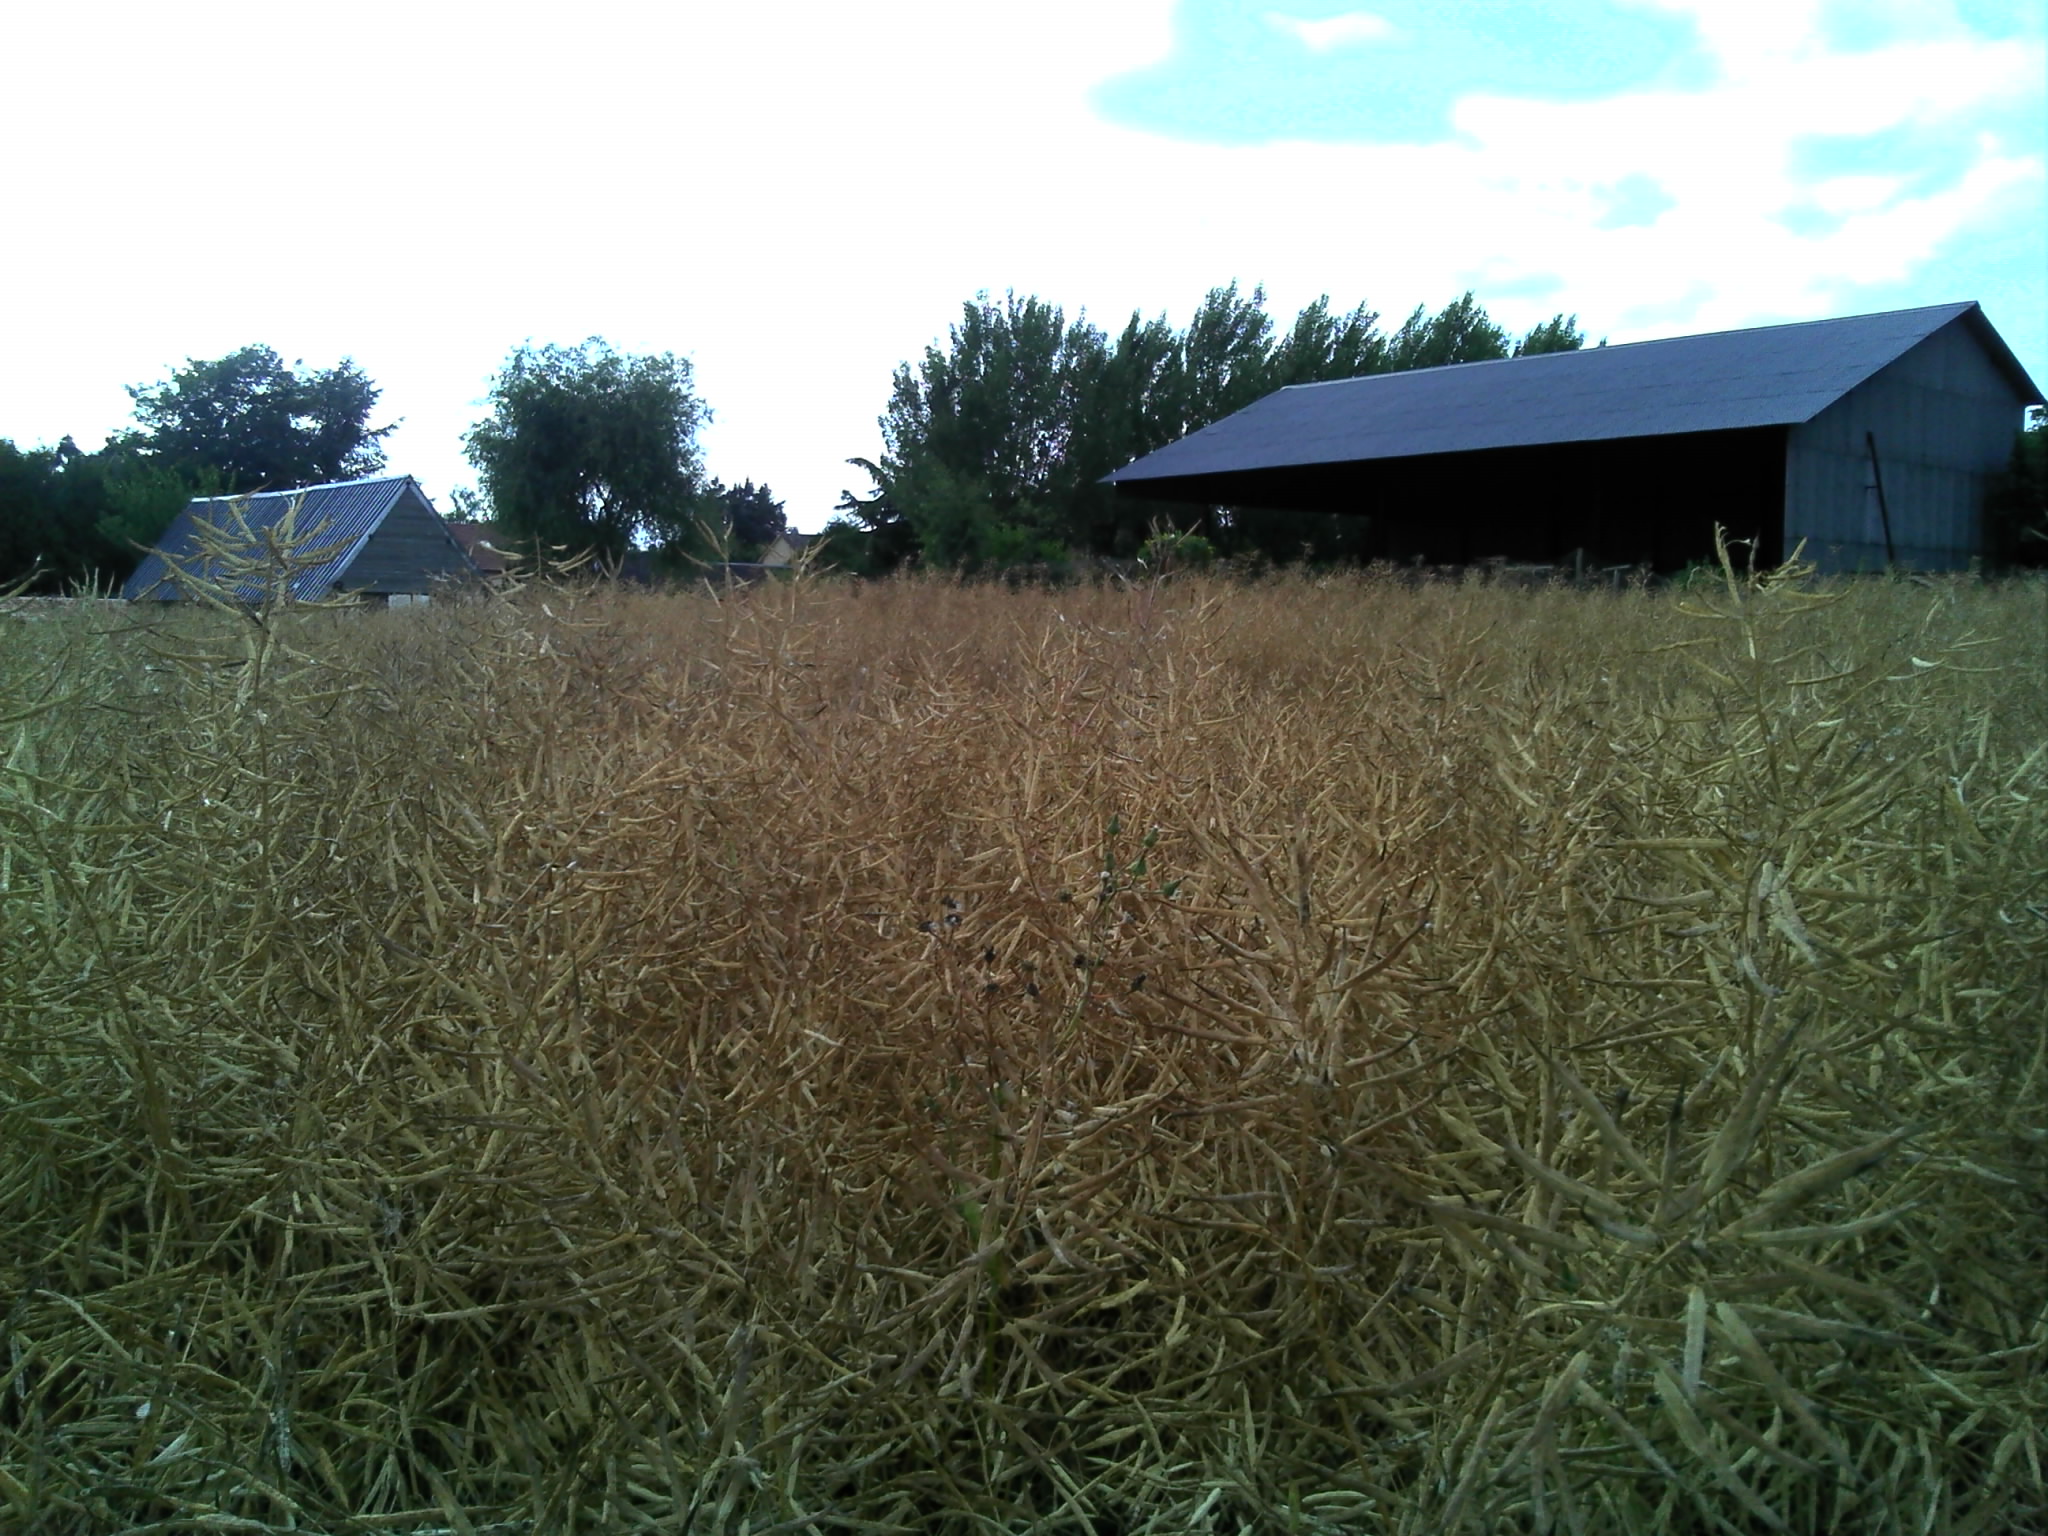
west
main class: Cropland
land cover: Rape and turnip rape
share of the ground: > 75 %
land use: Agriculture (excluding fallow land and kitchen gardens)
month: July
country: FR
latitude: 48.9482
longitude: 1.0900
